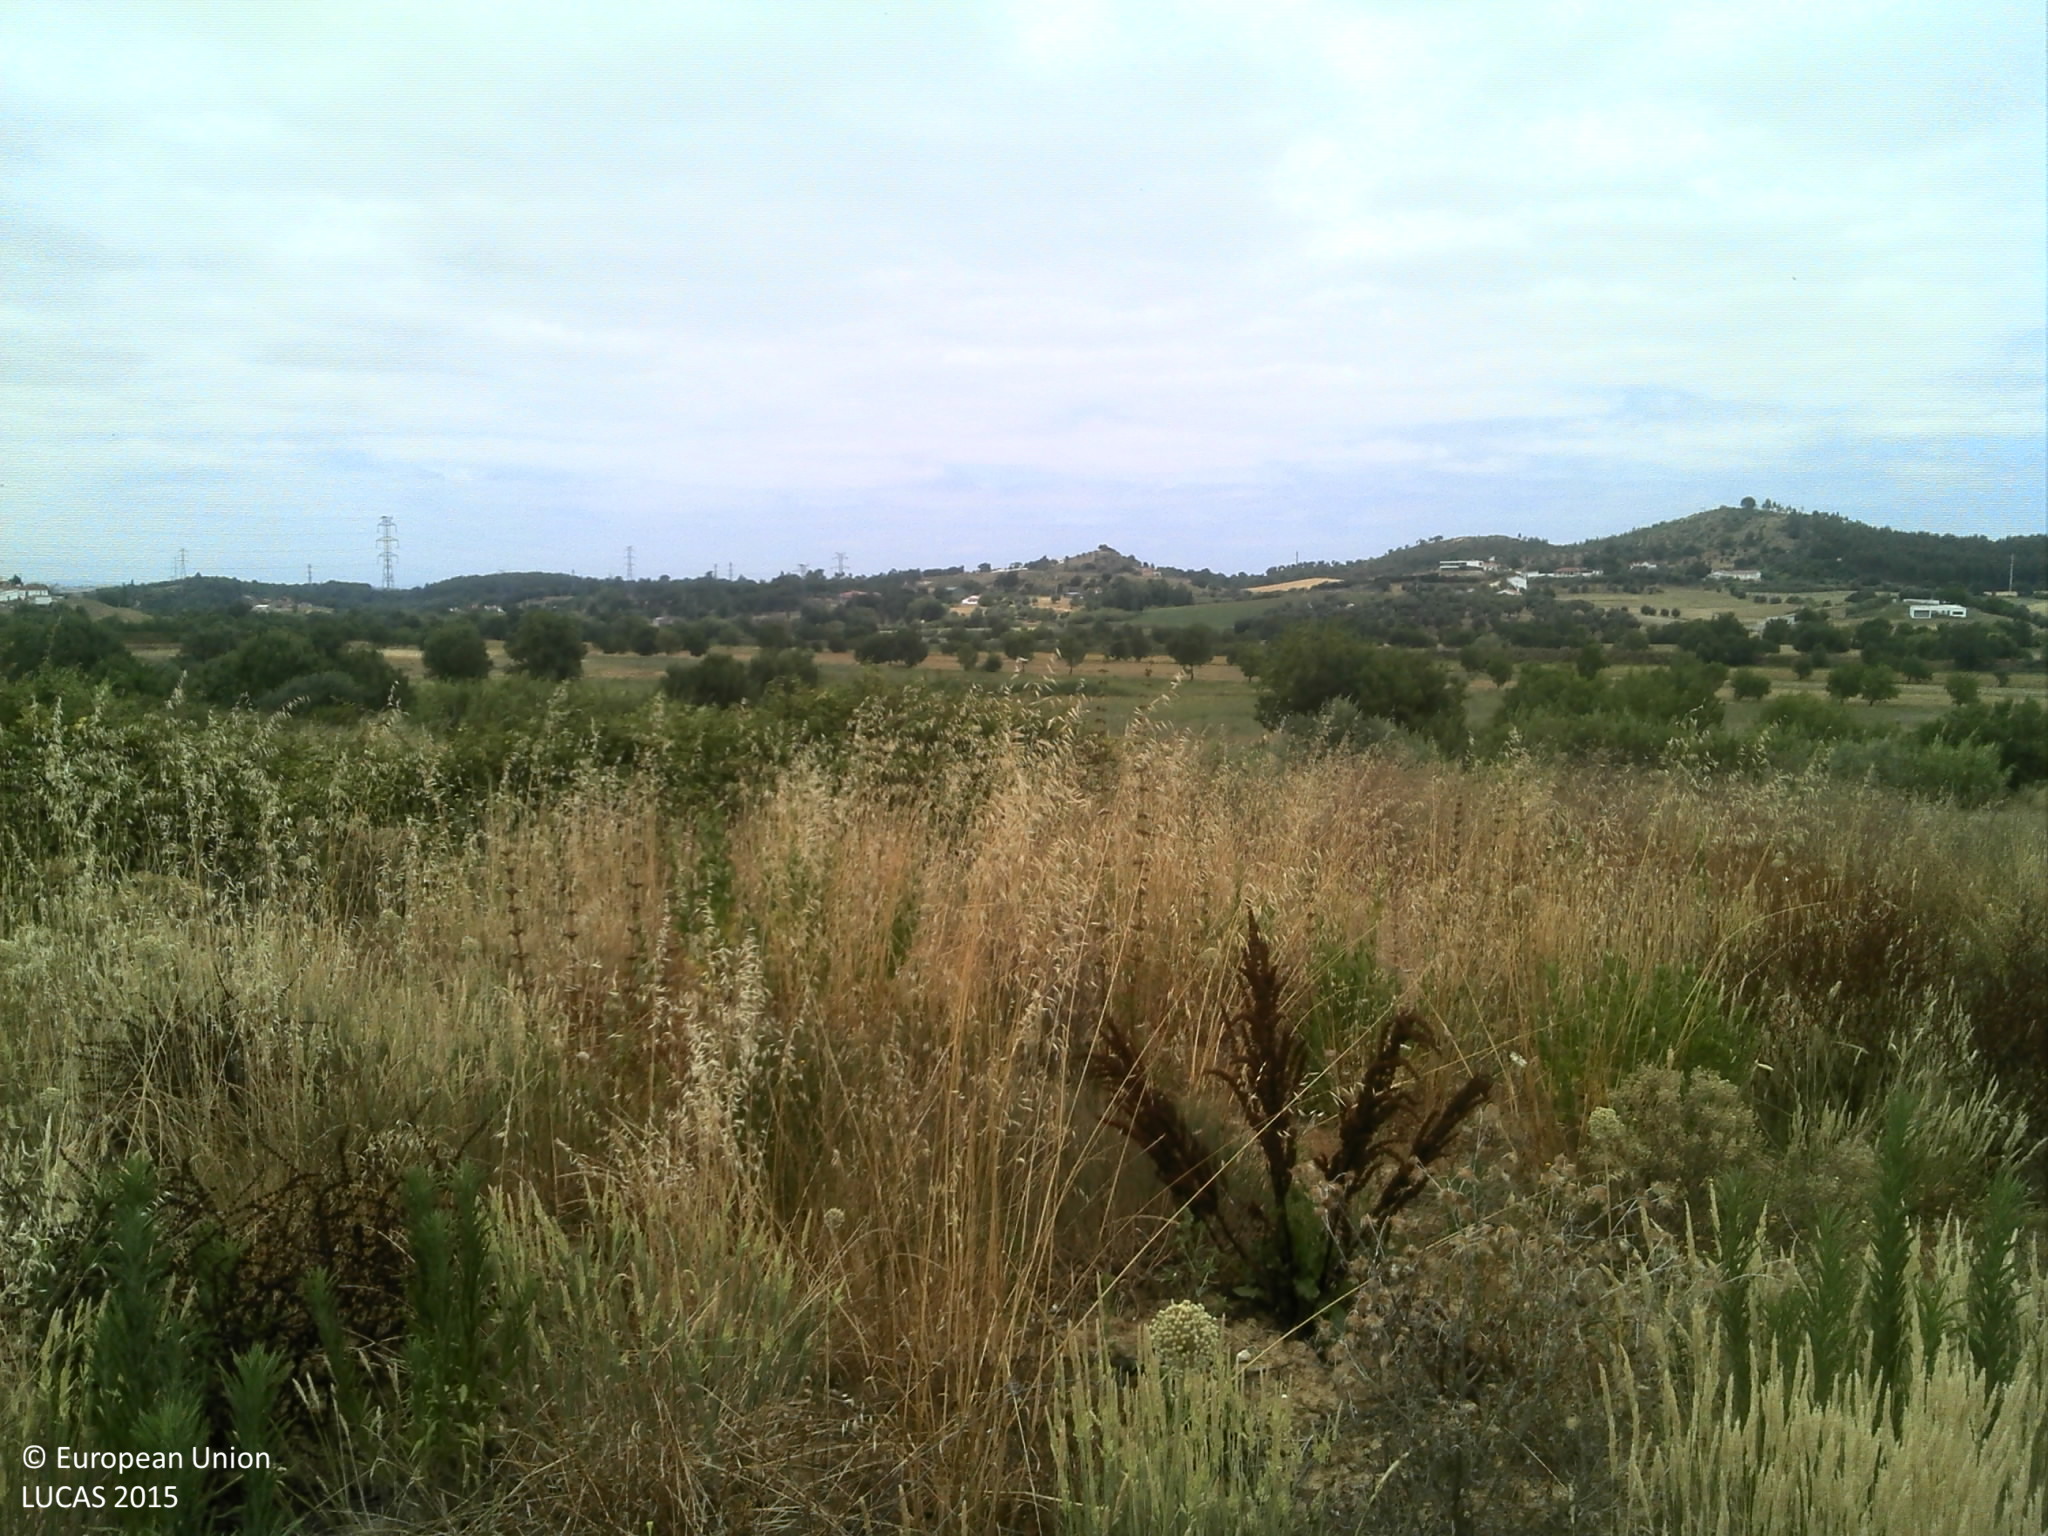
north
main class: Shrubland
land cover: Shrubland without tree cover
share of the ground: 50 - 75 %
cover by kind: shrubs 60 %, unconsolidated bare surface 30 %, herbaceous plants 10 %
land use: Abandoned areas
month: June
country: PT
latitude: 39.2221
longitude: -8.7339
